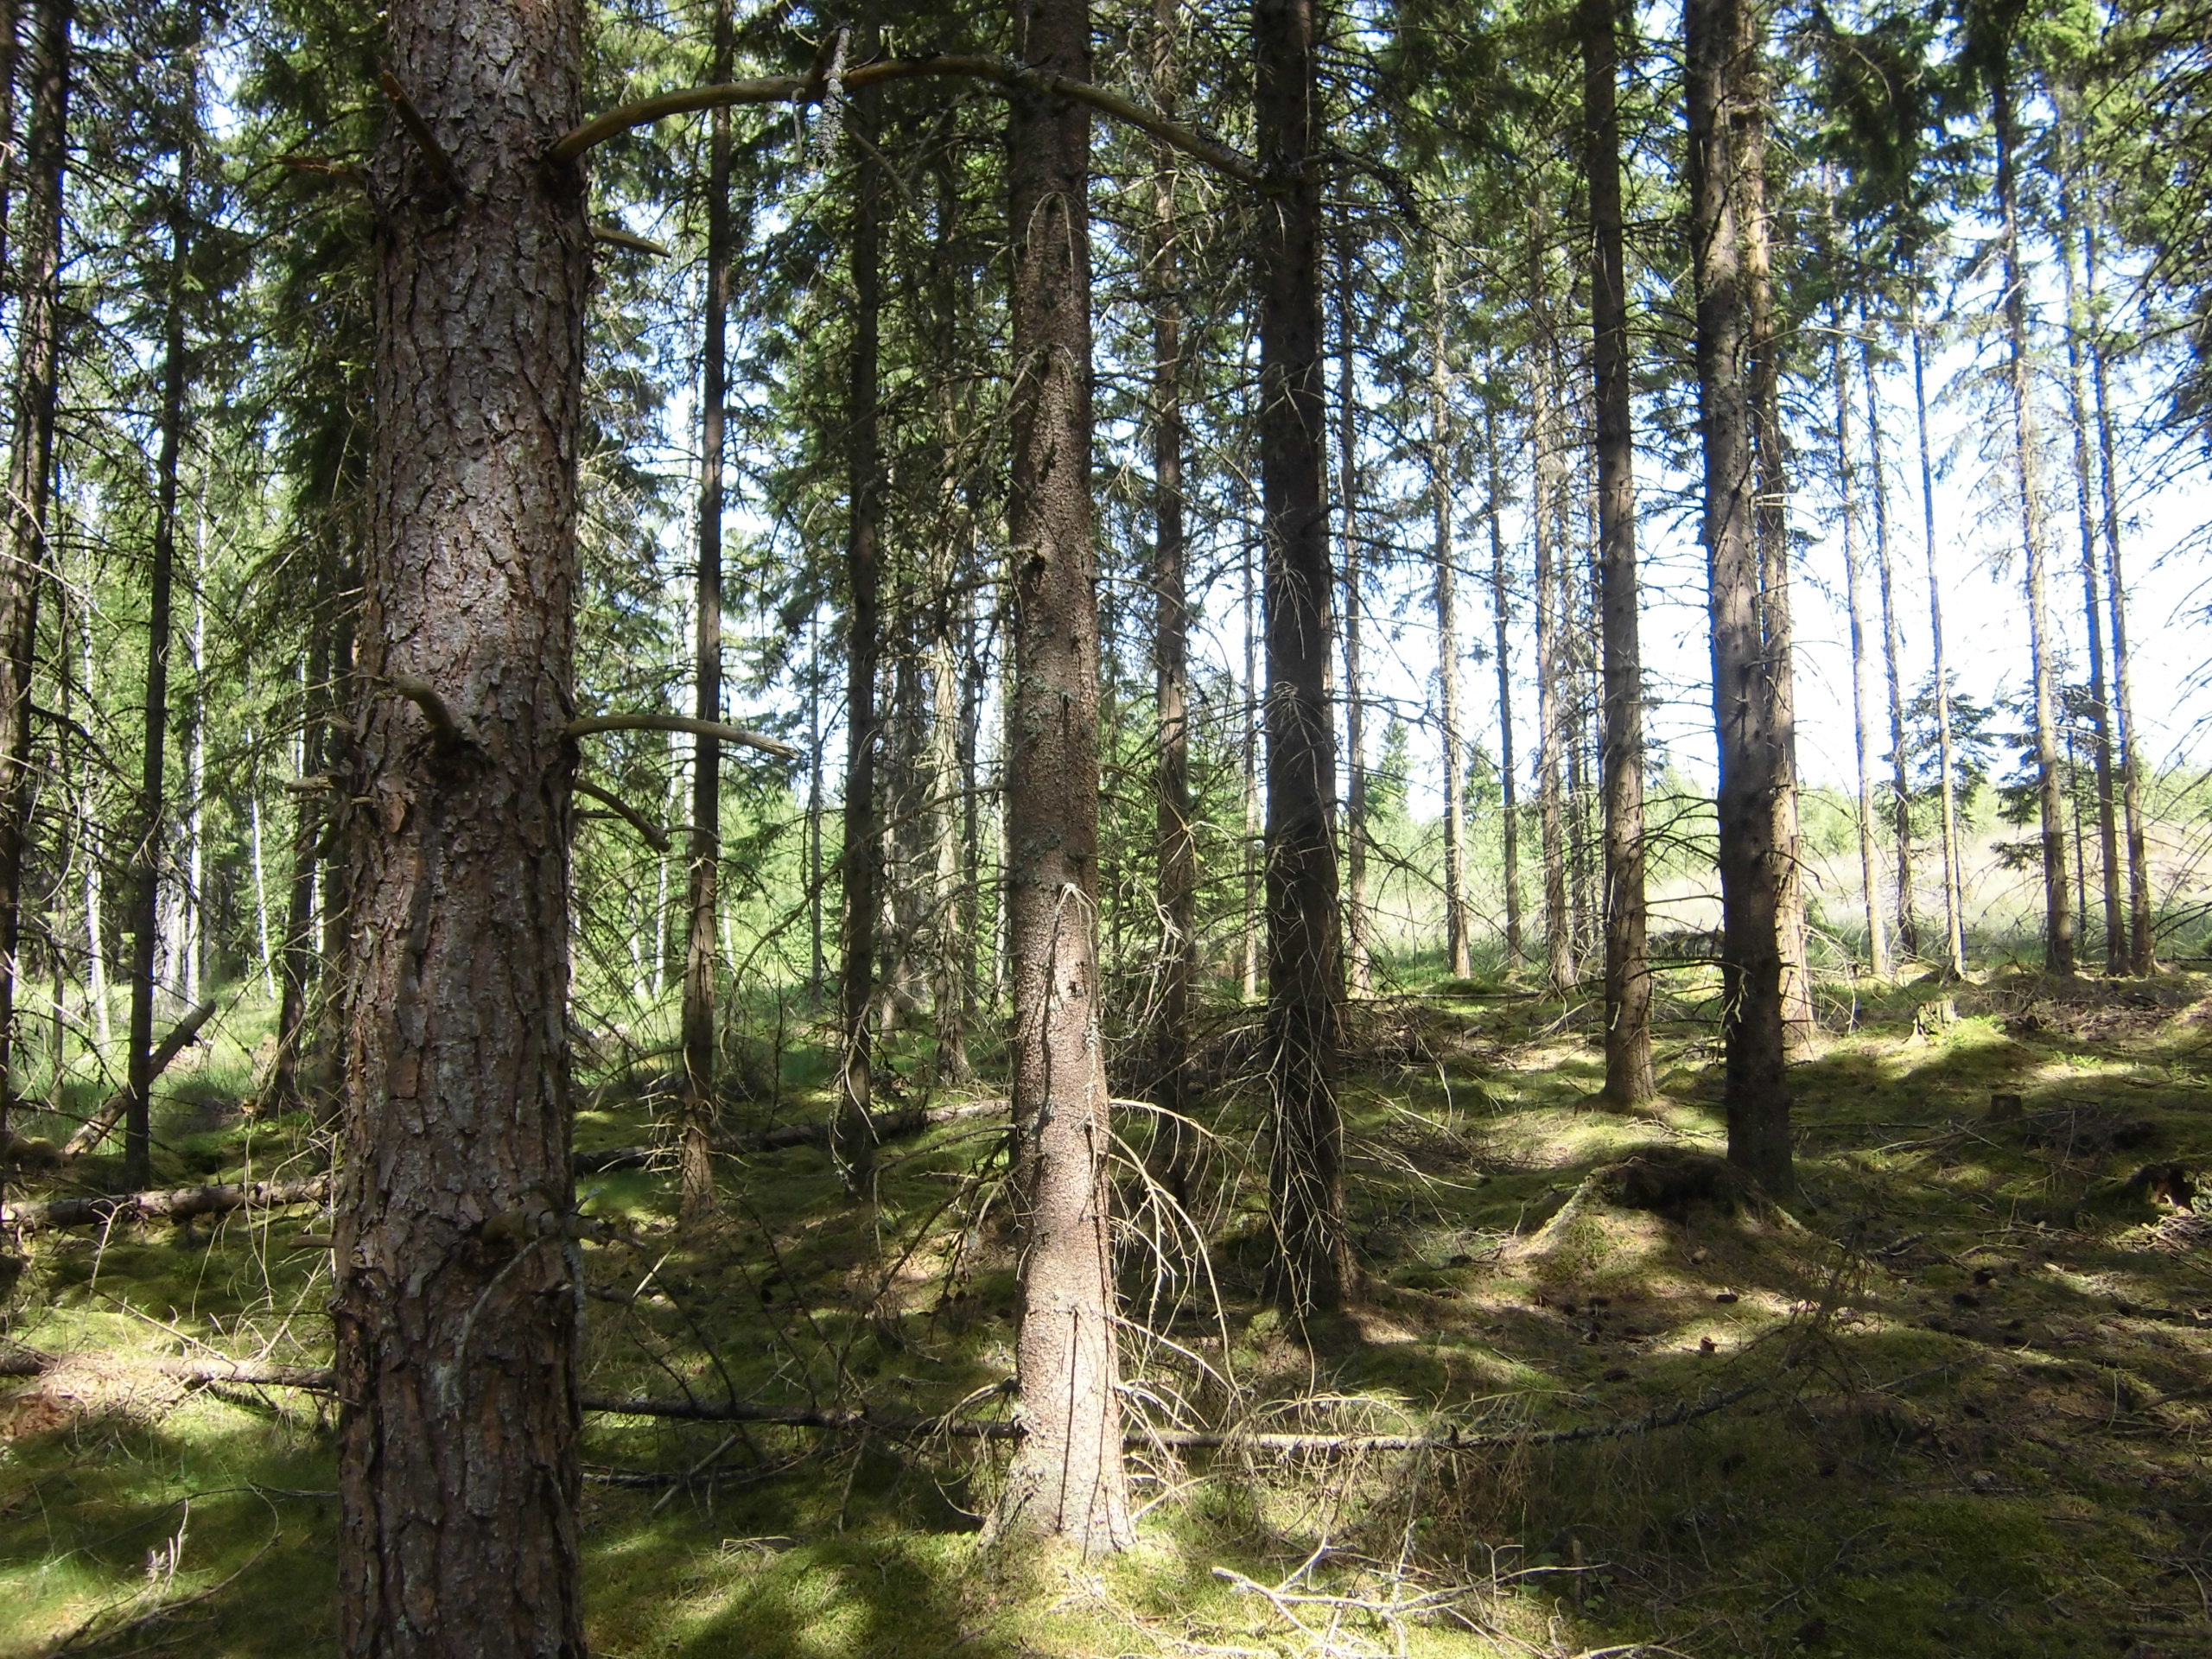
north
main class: Woodland
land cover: Spruce dominated coniferous woodland
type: boreal forest
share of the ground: 50 - 75 %
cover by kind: coniferous forest trees 55 %, shrubs 15 %, herbaceous plants 15 %, broadleaved forest trees 10 %, unconsolidated bare surface 5 %
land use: Forestry
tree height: > 5 m
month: July
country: SE
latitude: 57.2920
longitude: 14.6588
